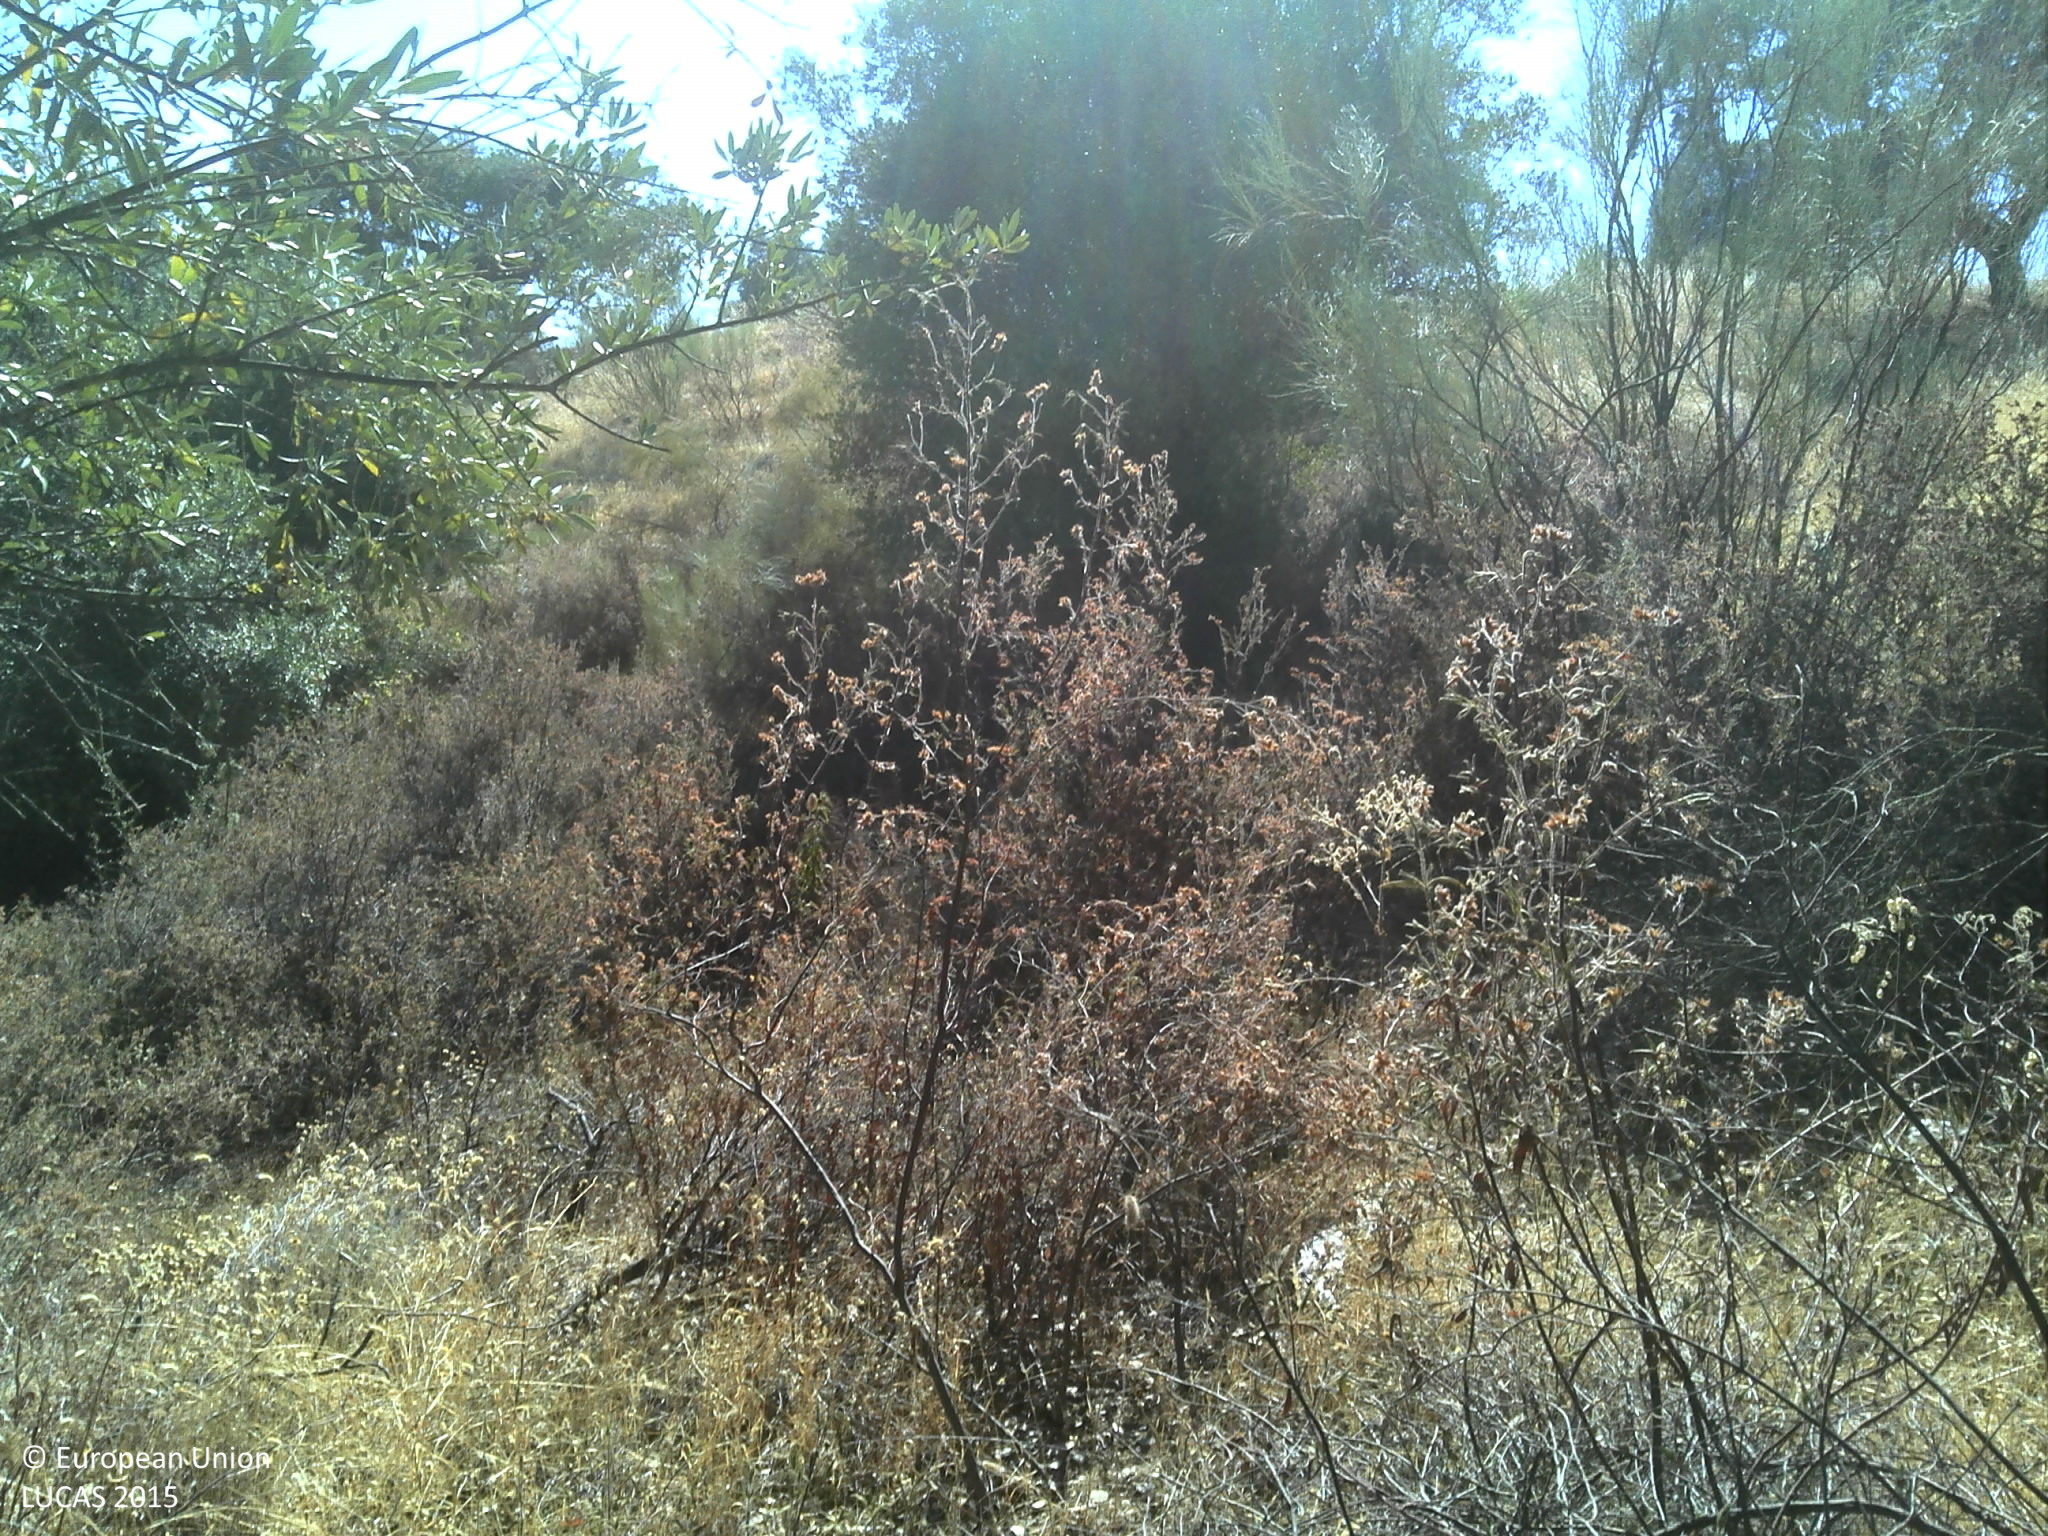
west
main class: Woodland
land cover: Broadleaved woodland
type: broadleaved evergreen forest
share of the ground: 50 - 75 %
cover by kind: broadleaved forest trees 70 %, shrubs 20 %, unconsolidated bare surface 10 %
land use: Forestry
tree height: > 5 m
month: July
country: PT
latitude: 38.1920
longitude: -7.6438
